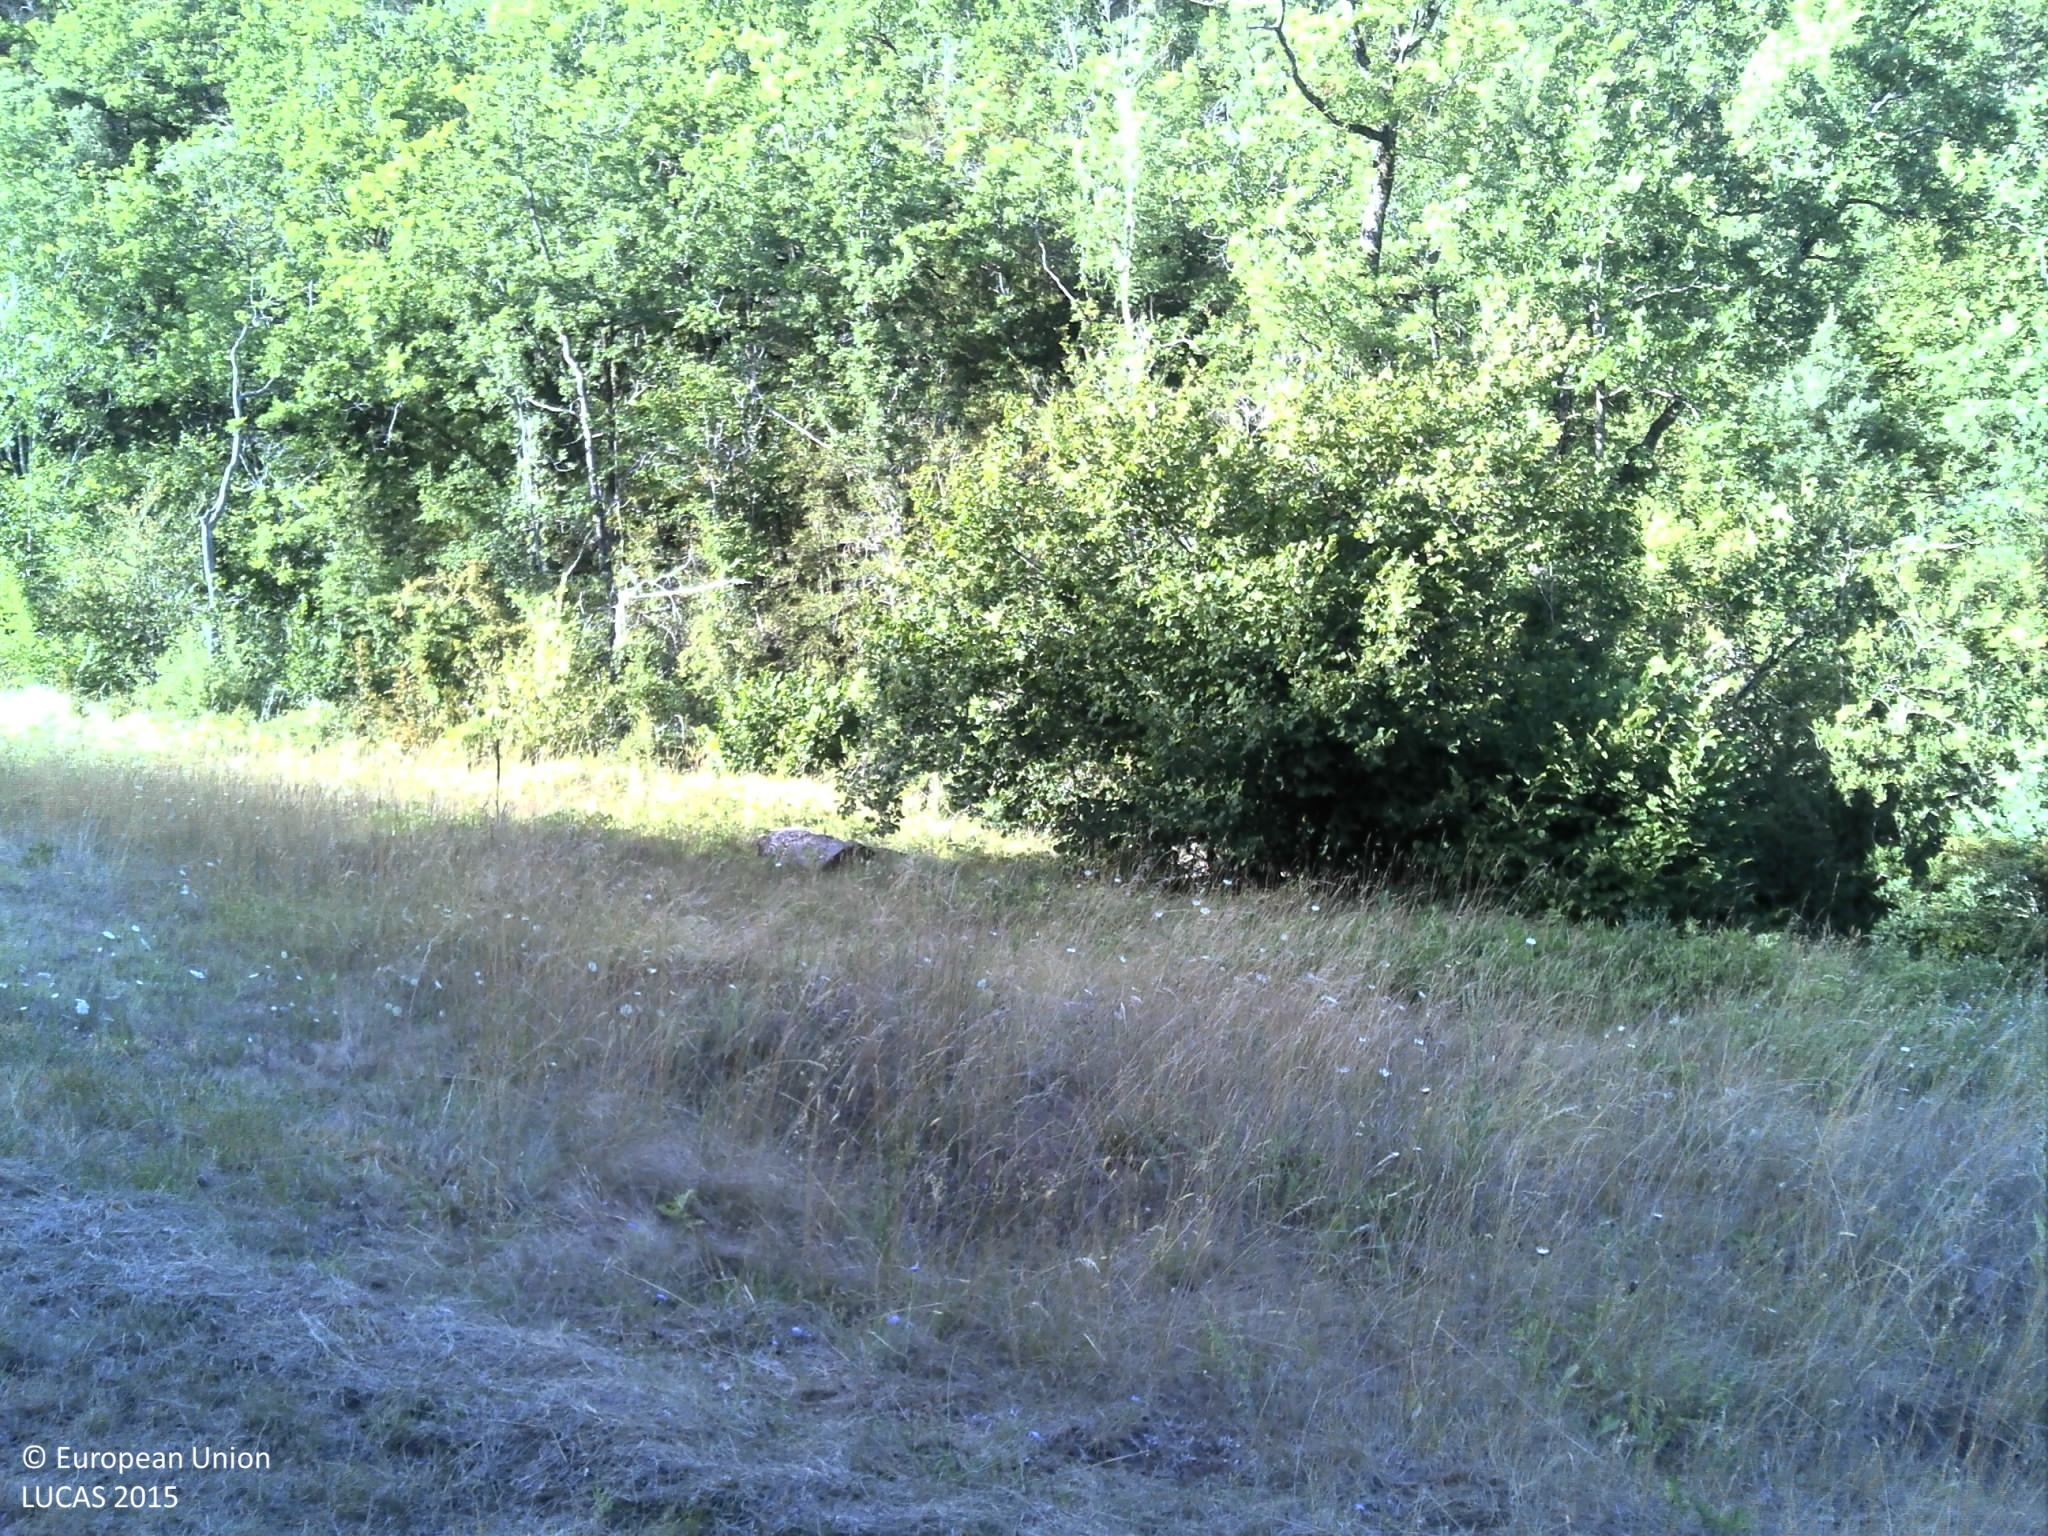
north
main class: Woodland
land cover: Broadleaved woodland
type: acidophilous oak and oak-birch forest
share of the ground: > 75 %
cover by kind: broadleaved forest trees 85 %, herbaceous plants 5 %, lichens and mosses 5 %, unconsolidated bare surface 5 %
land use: Semi-natural and natural areas not in use
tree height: > 5 m
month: July
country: FR
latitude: 43.7614
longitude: 3.1385
